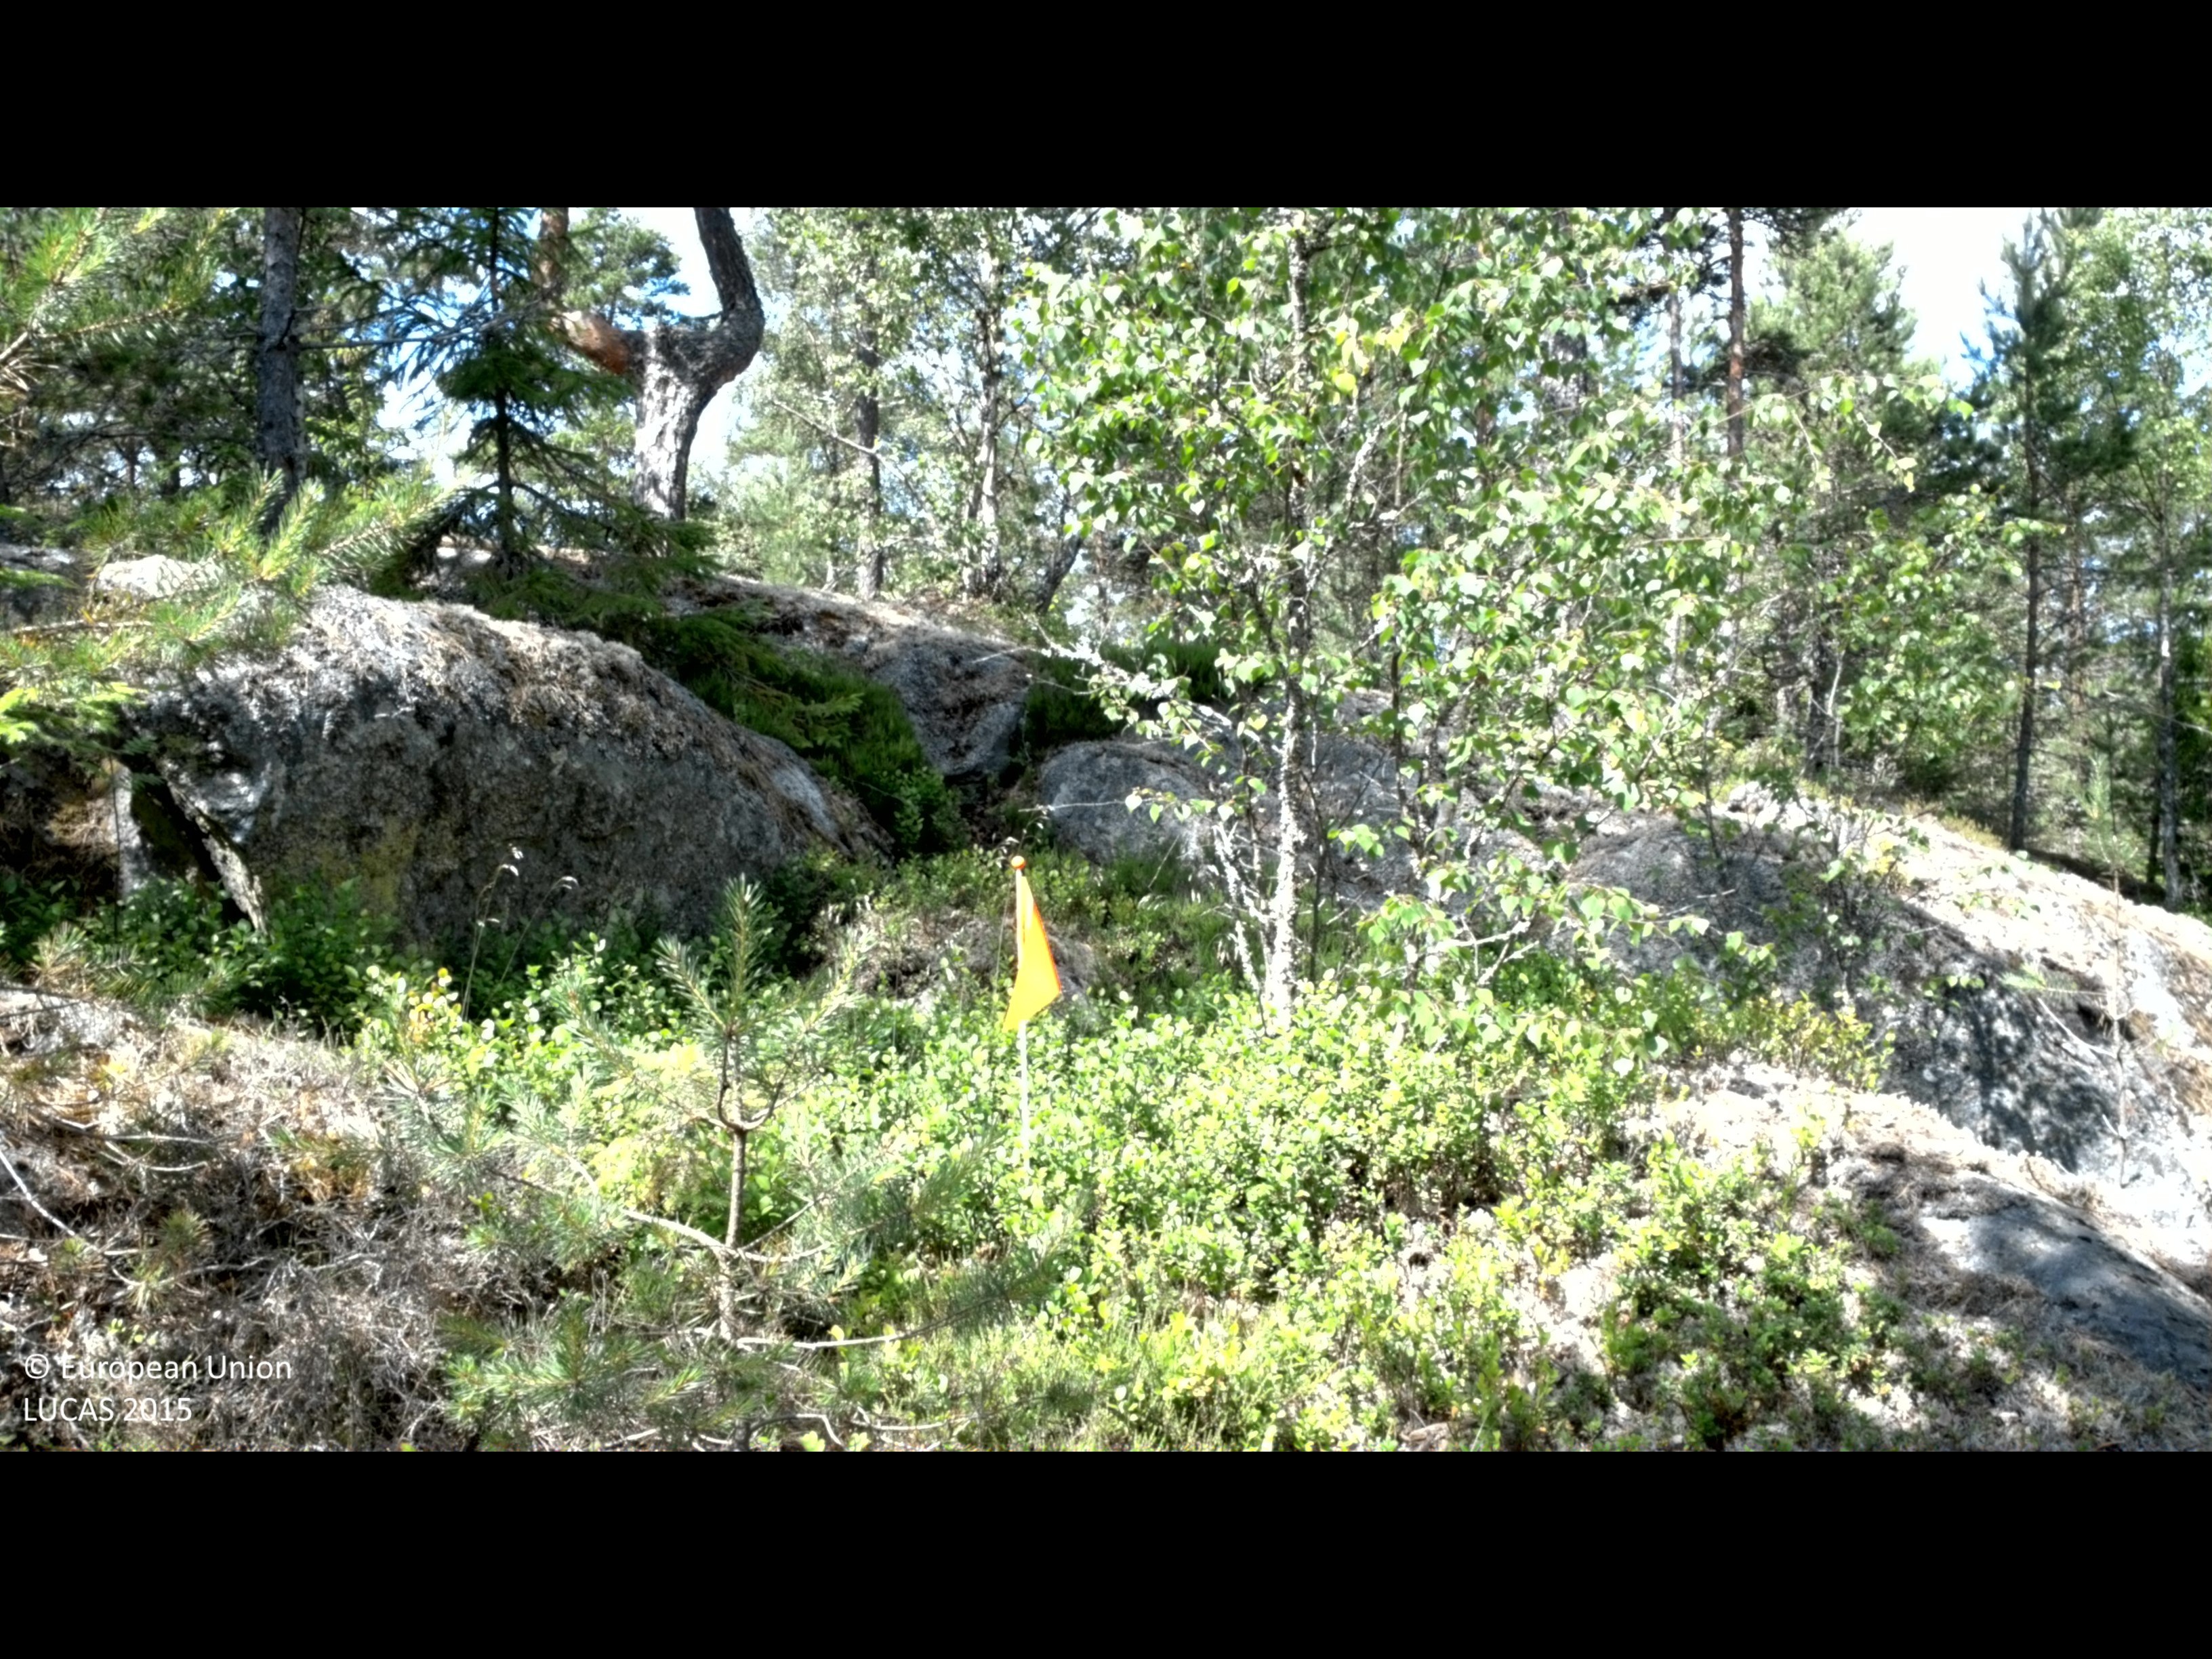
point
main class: Woodland
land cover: Pine dominated mixed woodland
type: boreal forest
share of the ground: 50 - 75 %
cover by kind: coniferous forest trees 45 %, shrubs 20 %, lichens and mosses 20 %, broadleaved forest trees 15 %
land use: Forestry
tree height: > 5 m
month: June
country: SE
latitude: 58.2071
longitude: 16.1054
